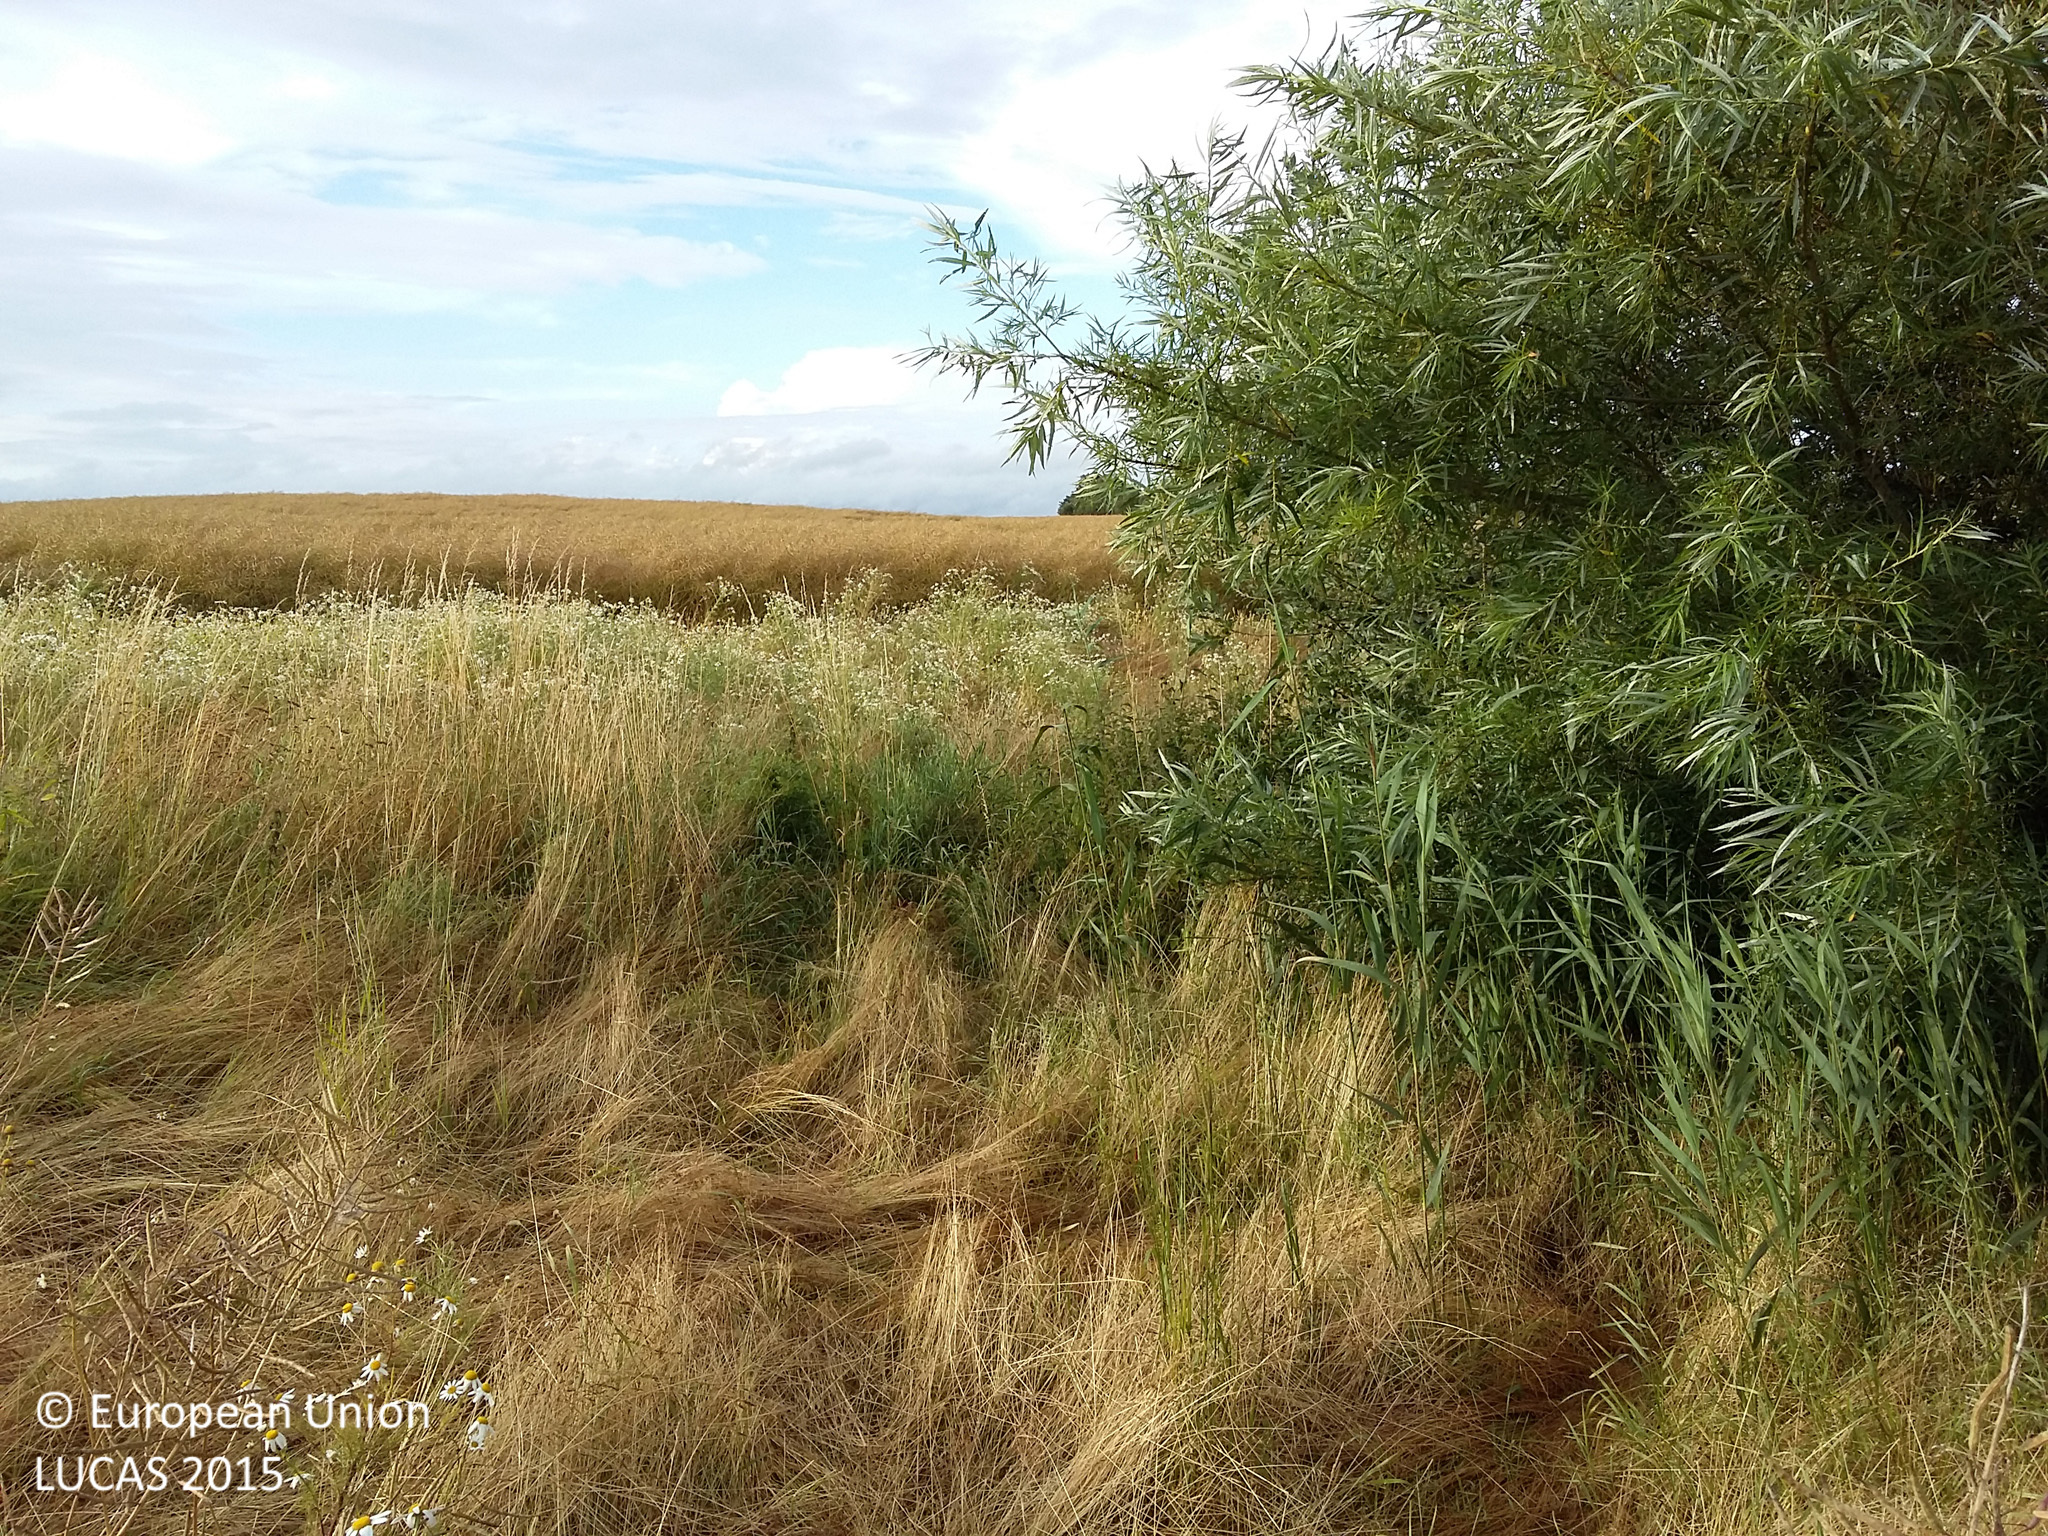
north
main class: Cropland
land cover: Rape and turnip rape
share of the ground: > 75 %
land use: Agriculture (excluding fallow land and kitchen gardens)
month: July
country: DK
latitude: 55.8640
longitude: 12.1551
